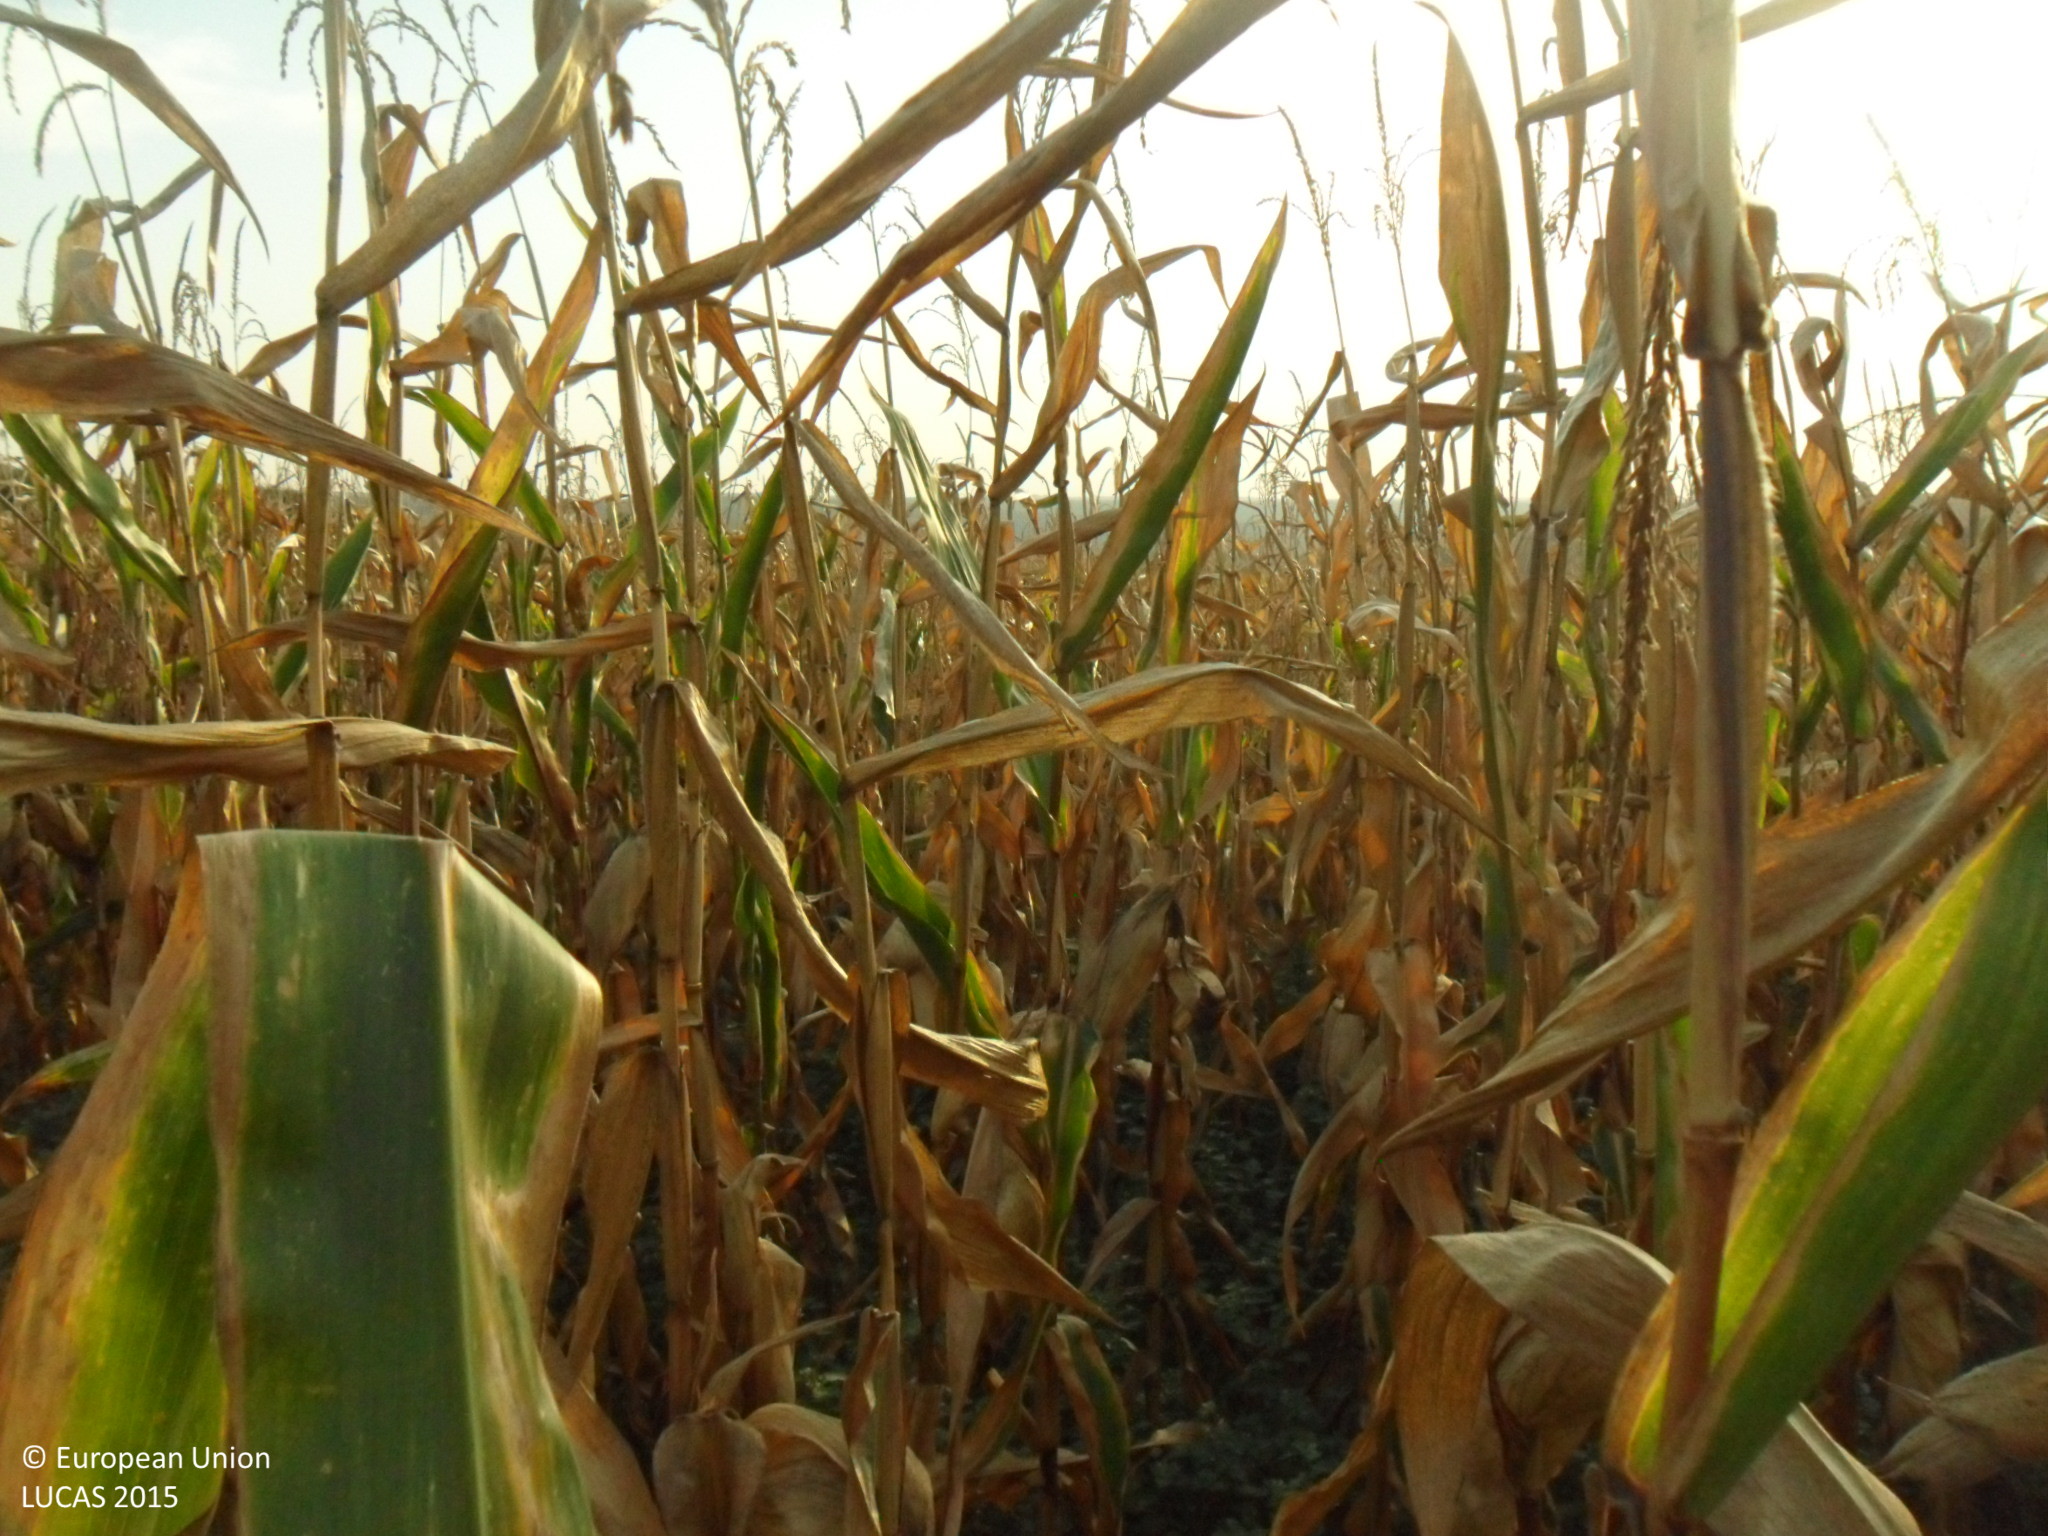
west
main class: Cropland
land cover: Maize
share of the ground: > 75 %
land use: Agriculture (excluding fallow land and kitchen gardens)
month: September
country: BG
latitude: 43.5840
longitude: 26.1856
